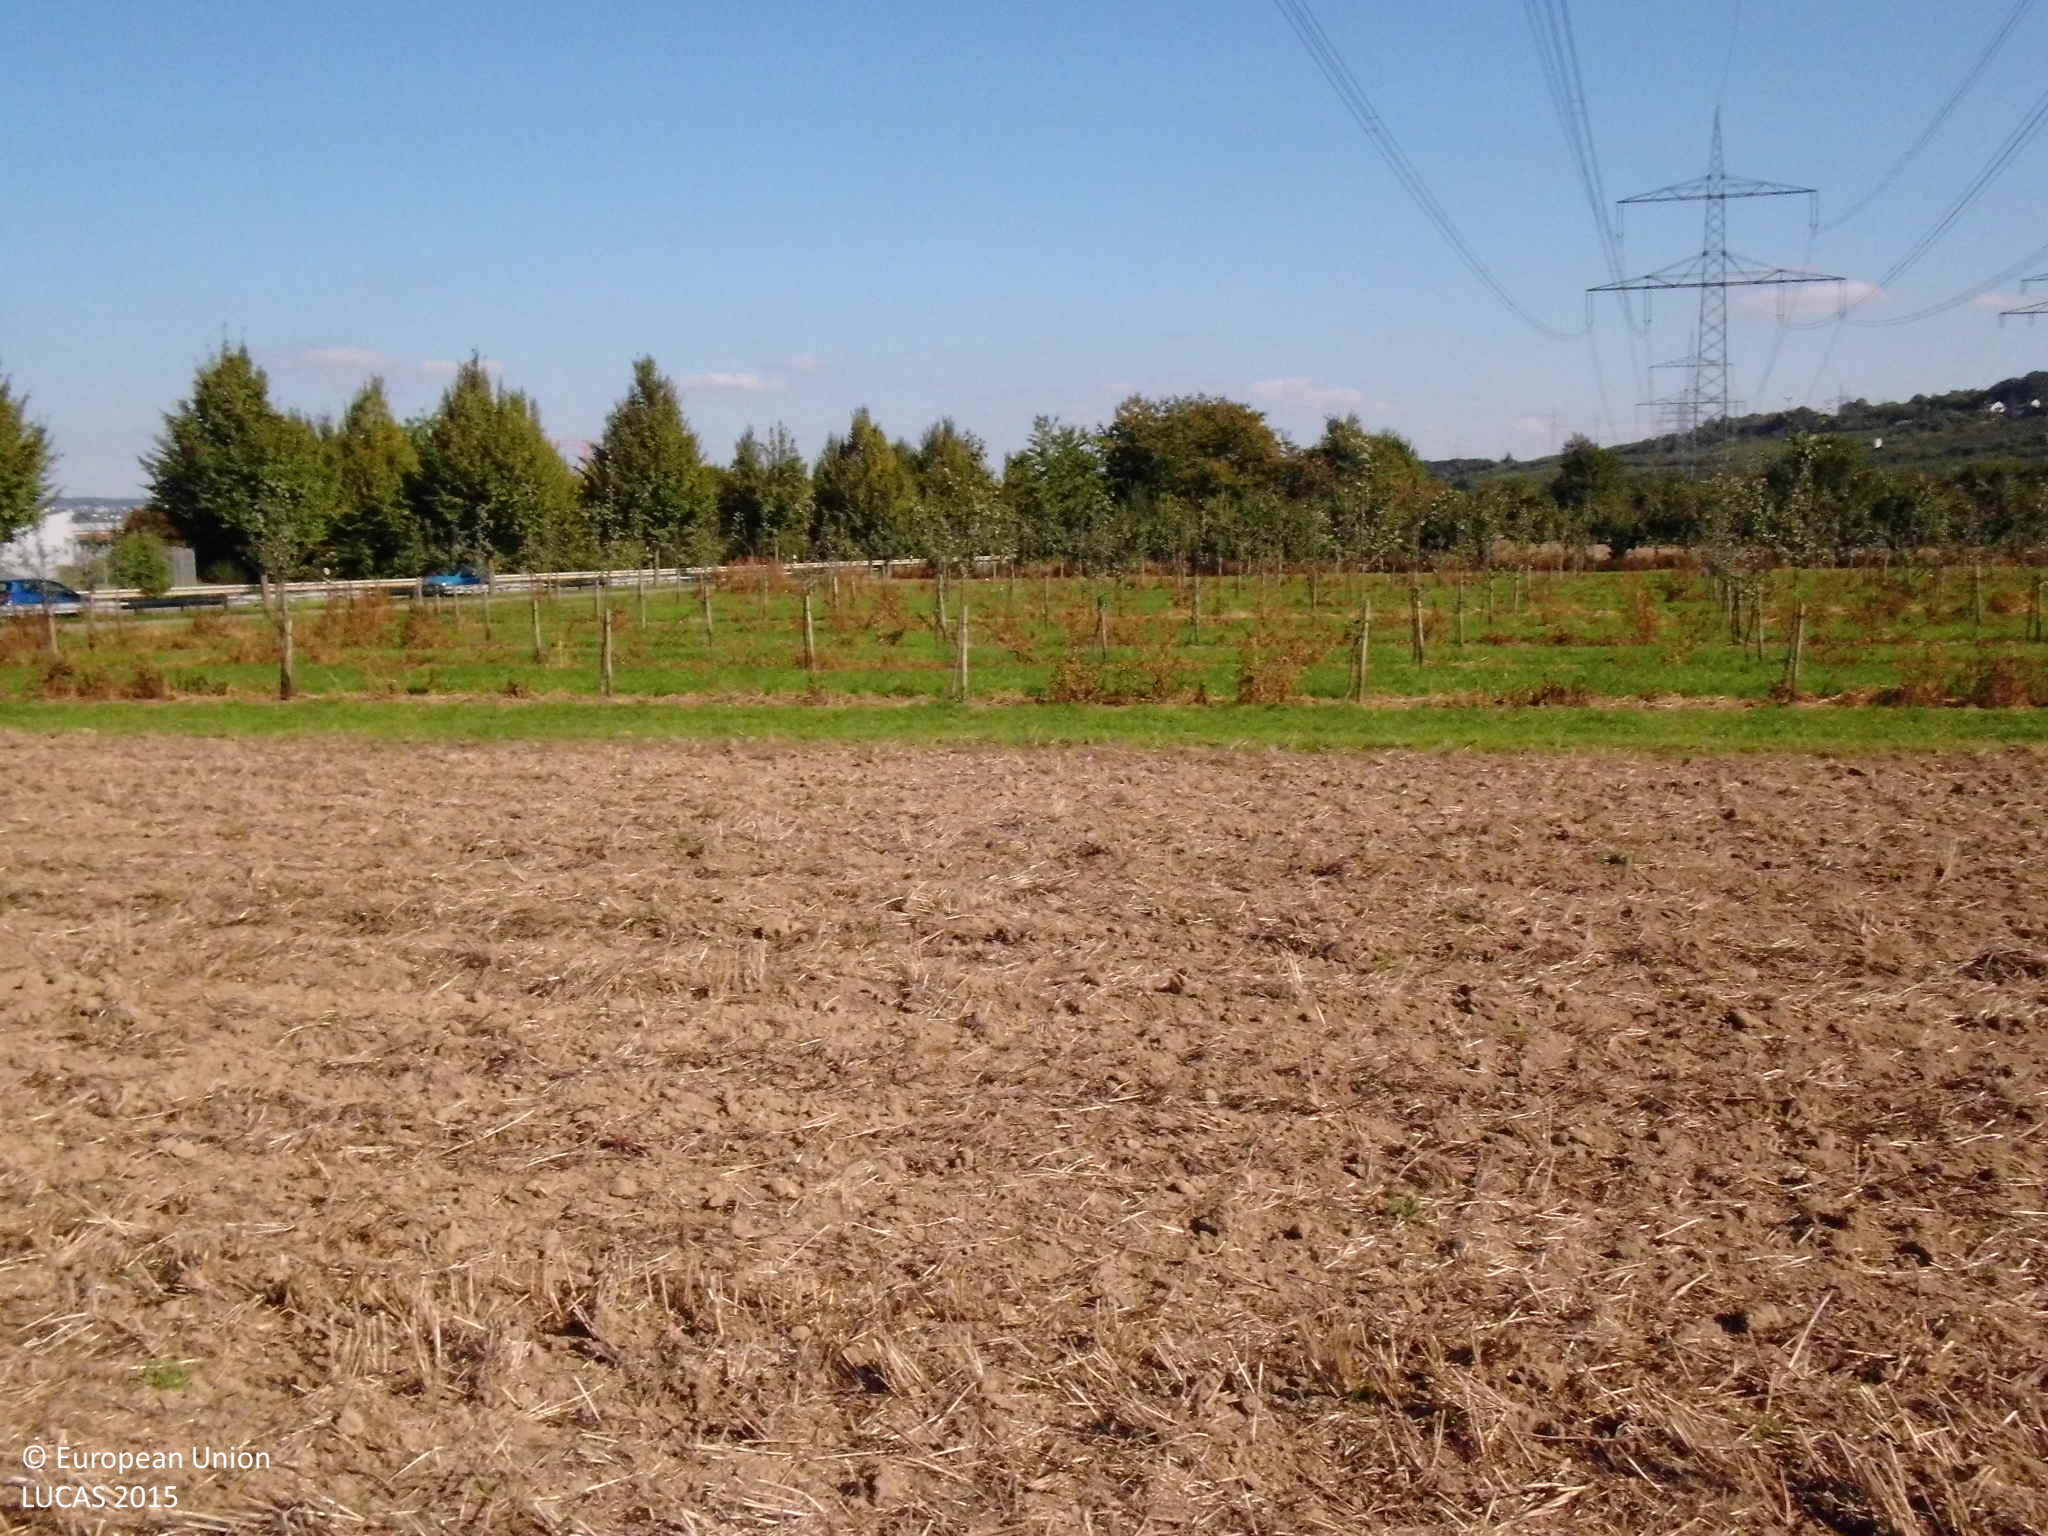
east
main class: Artificial land
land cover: Other artificial areas
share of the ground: < 10 %
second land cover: Common wheat
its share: < 10 %
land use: Electricity, gas and thermal power distribution
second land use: Agriculture (excluding fallow land and kitchen gardens)
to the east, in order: Electric lines; Common wheat; Grass margins; Other fruit trees and berries; Grassland without tree/shrub cover; Apple fruit; Grassland without tree/shrub cover; Shruby margins; Paved roads, cycling and walking lanes; Grass margins; Lines of trees; Grass margins; Paved roads, cycling and walking lanes; Grass margins; Lines of trees; Grass margins; Paved roads, cycling and walking lanes; Grass margins; Broadleaved woodland; Shrubland without tree cover
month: September
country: DE
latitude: 50.3910
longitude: 7.5106
